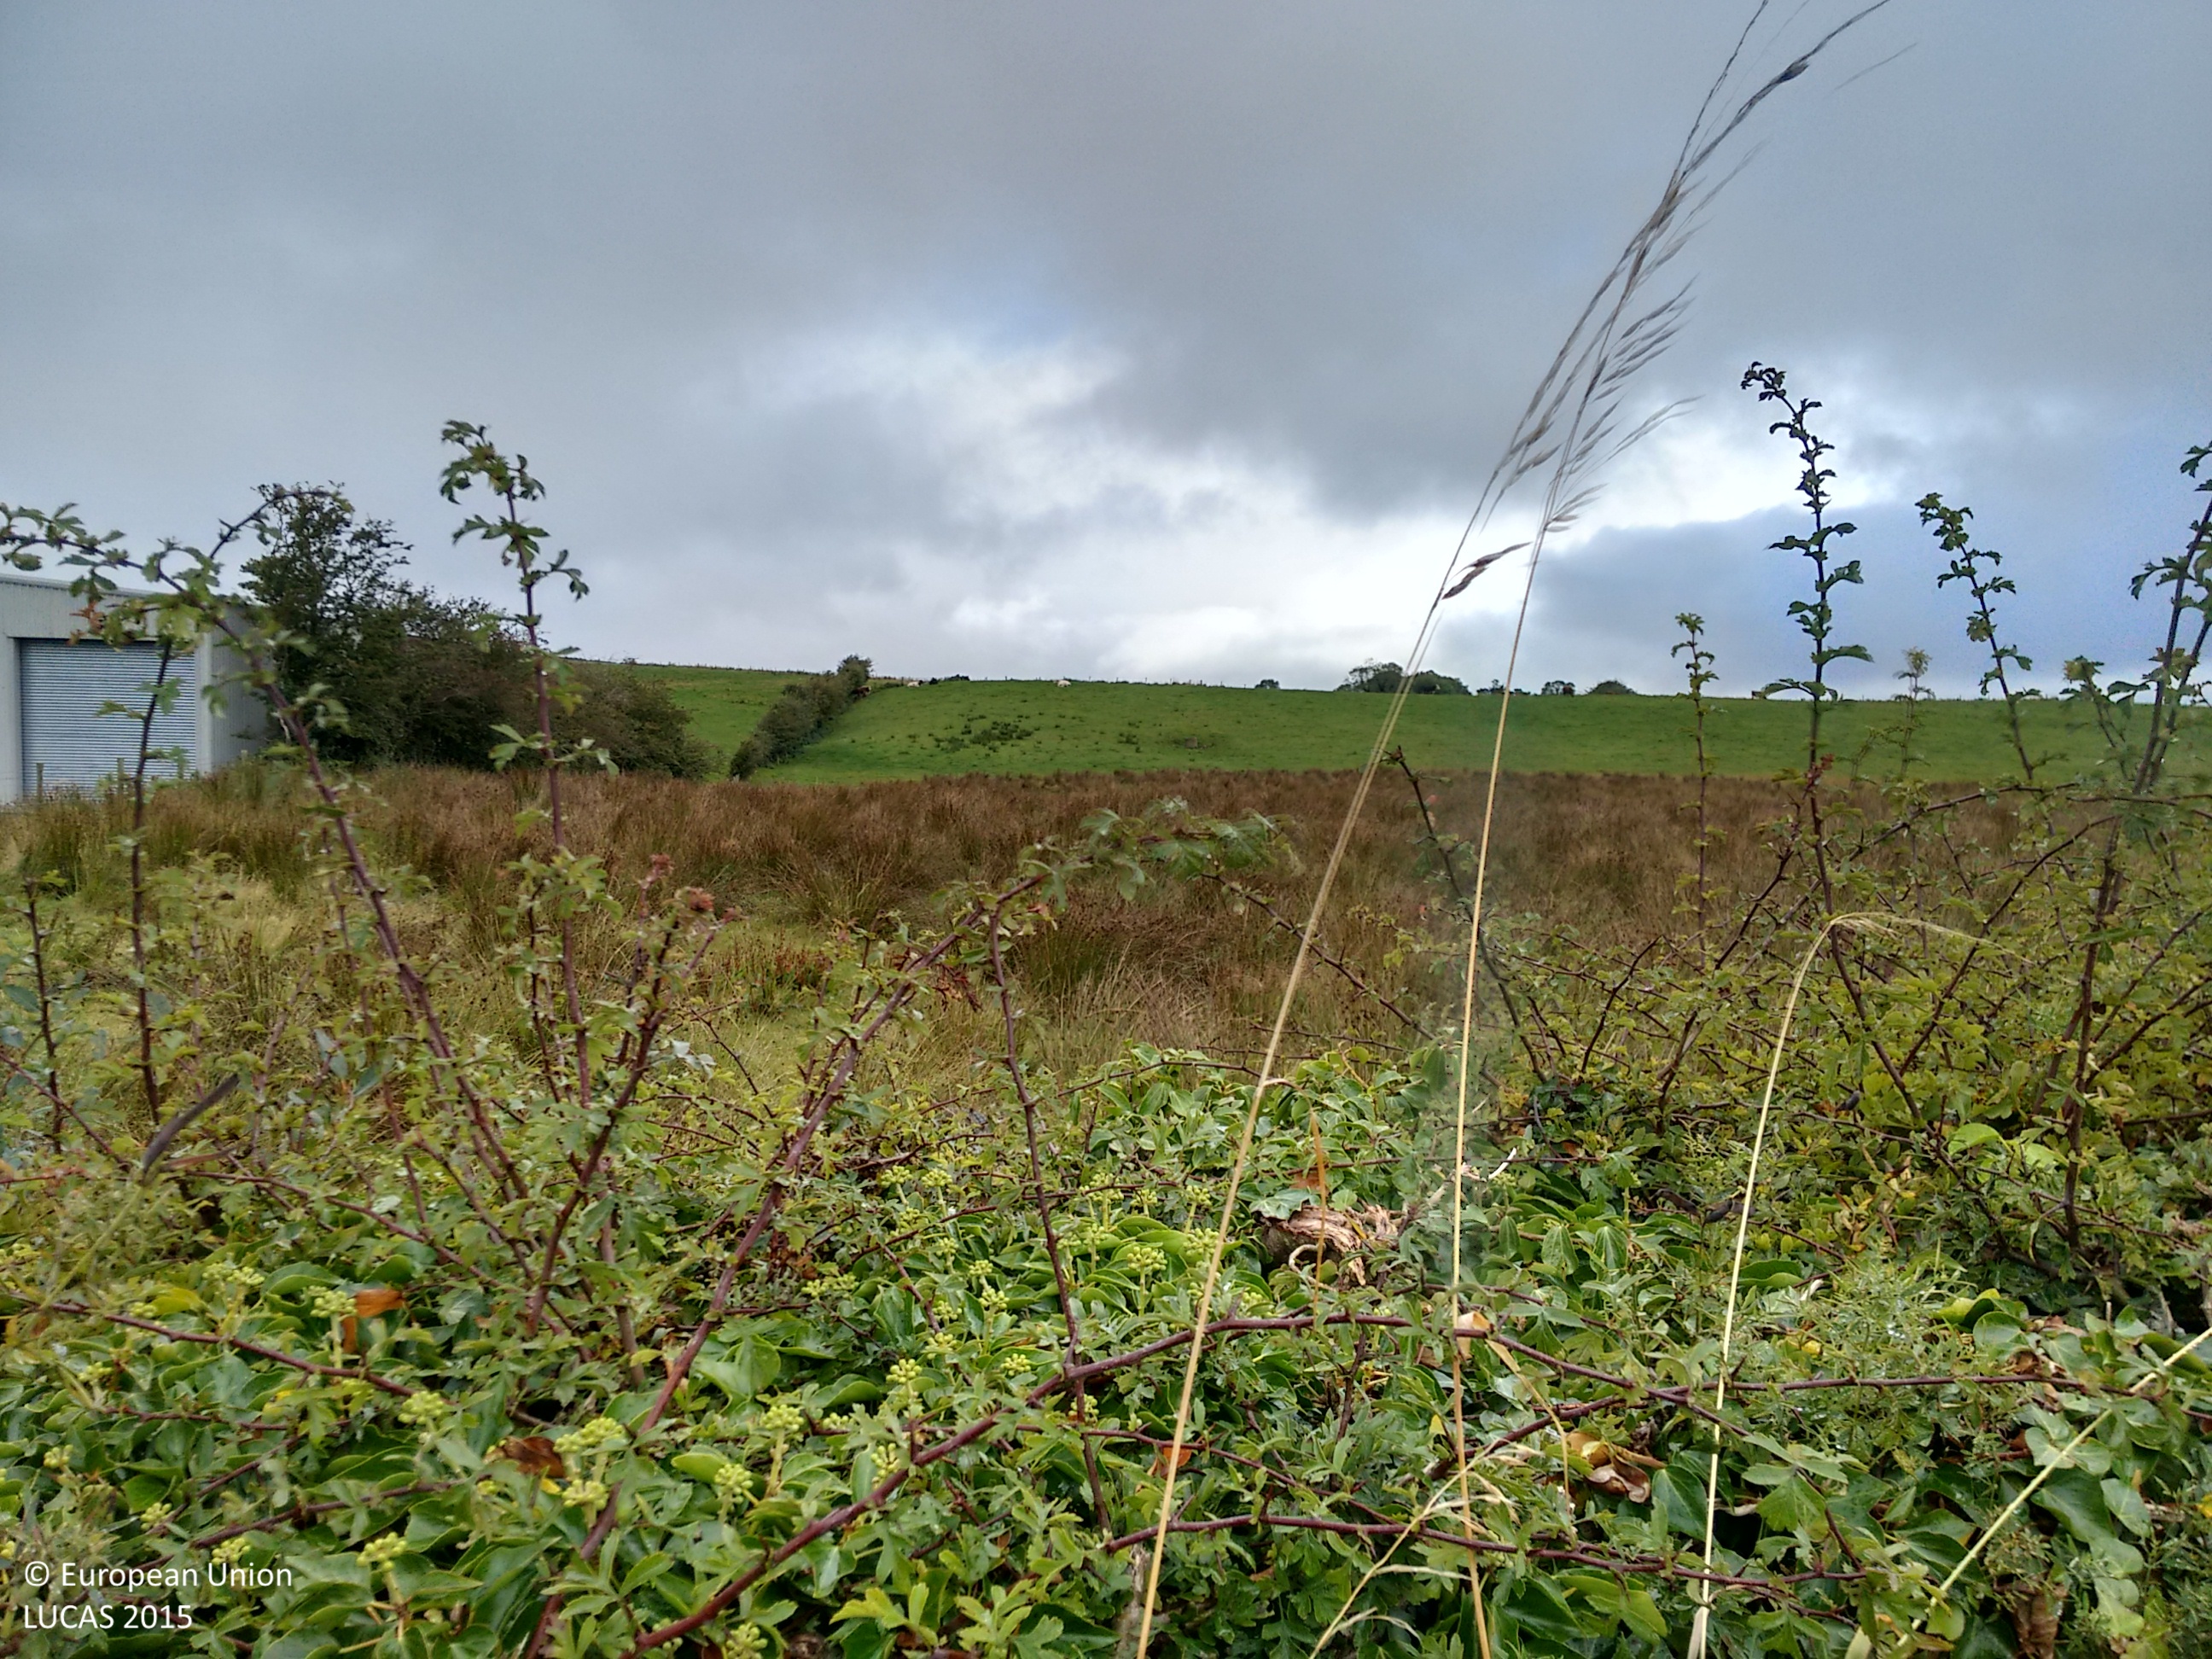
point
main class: Grassland
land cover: Grassland without tree/shrub cover
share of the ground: > 75 %
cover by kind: herbaceous plants 100 %
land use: Agriculture (excluding fallow land and kitchen gardens)
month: September
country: IE
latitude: 54.9604
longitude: -7.5702
